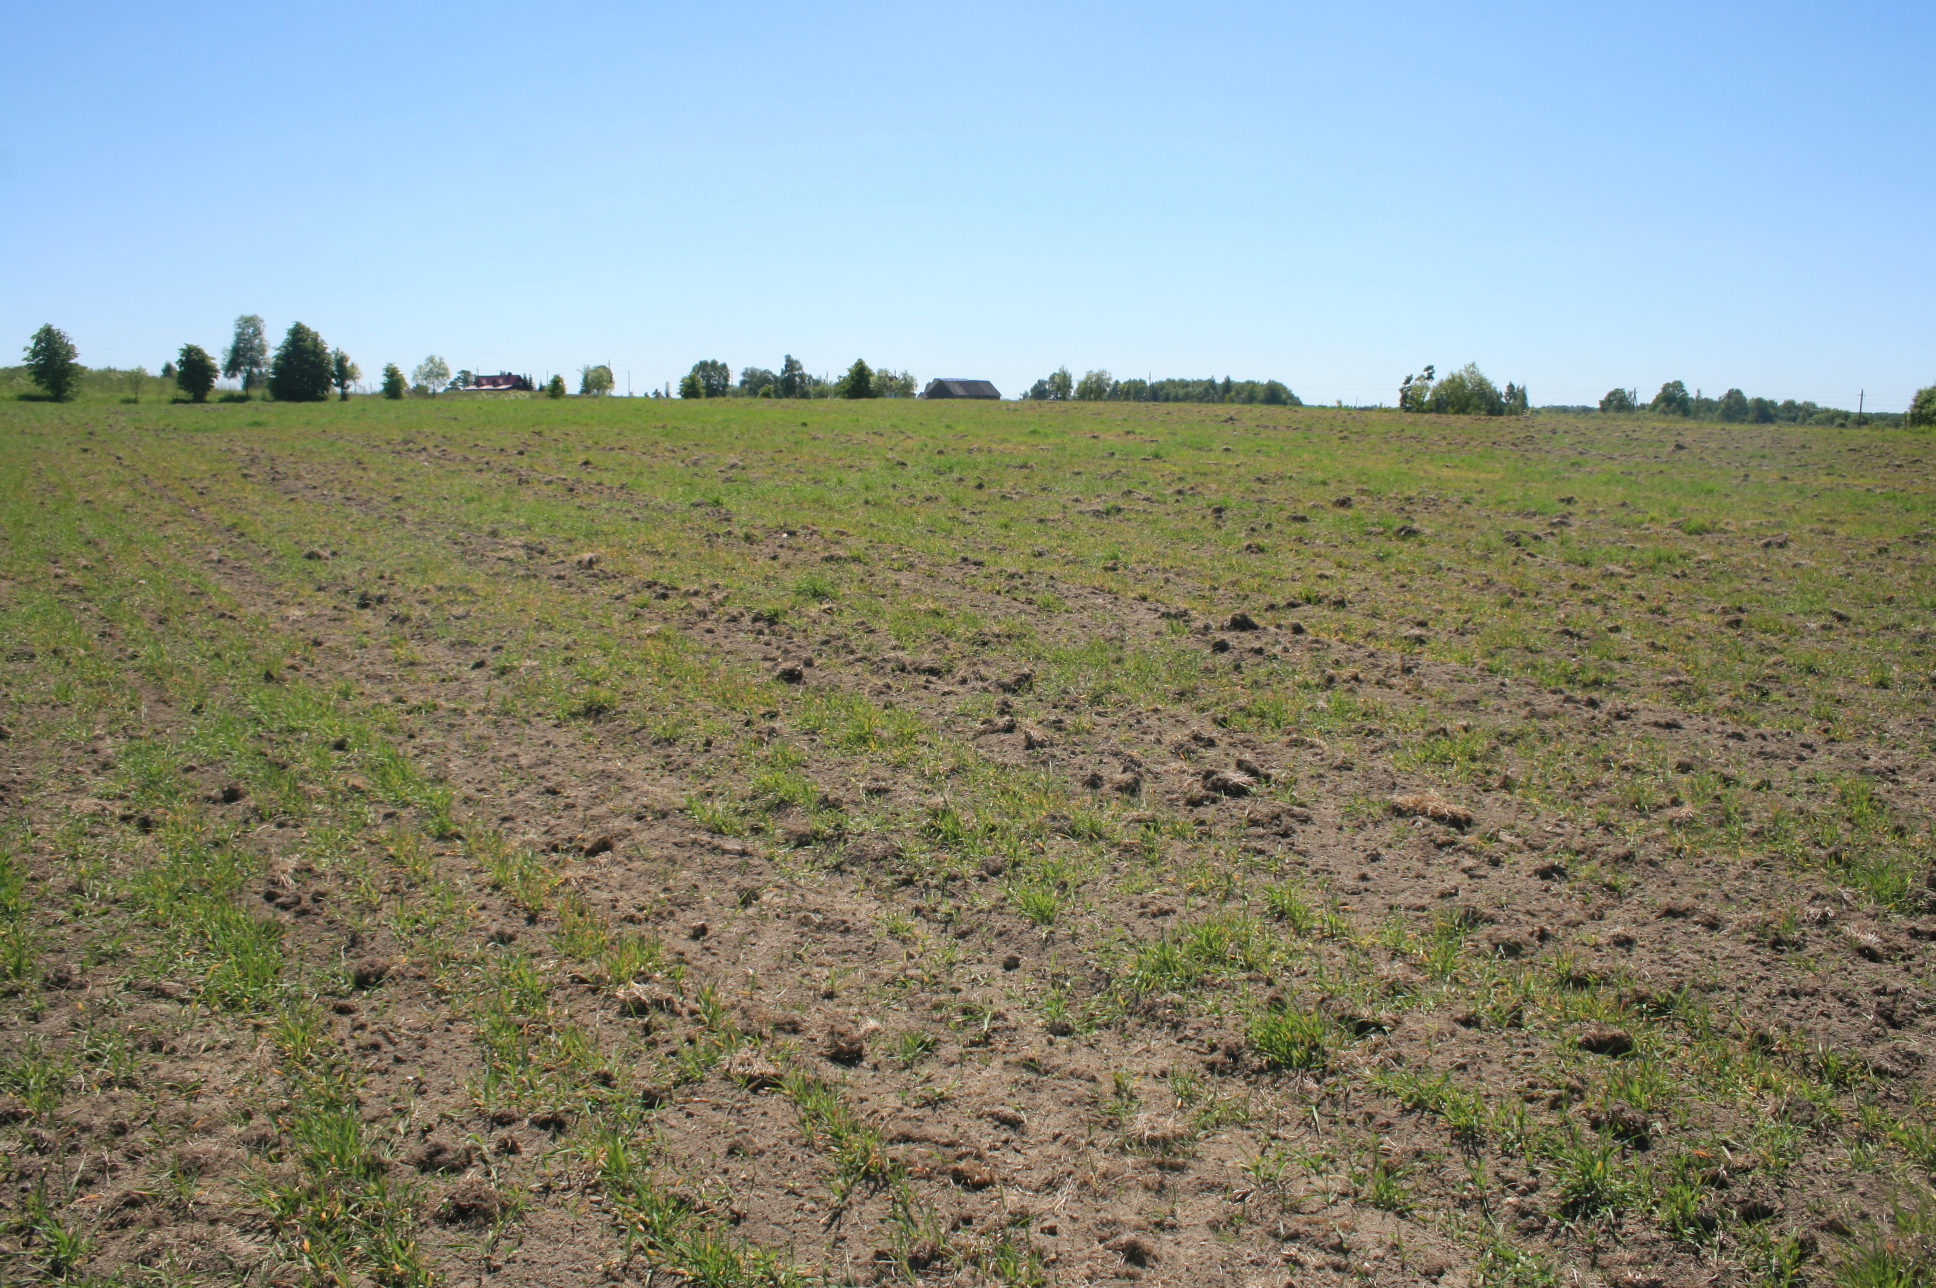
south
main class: Cropland
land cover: Barley
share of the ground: 25 - 50 %
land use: Agriculture (excluding fallow land and kitchen gardens)
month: June
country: LT
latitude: 55.5325
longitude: 22.1761
